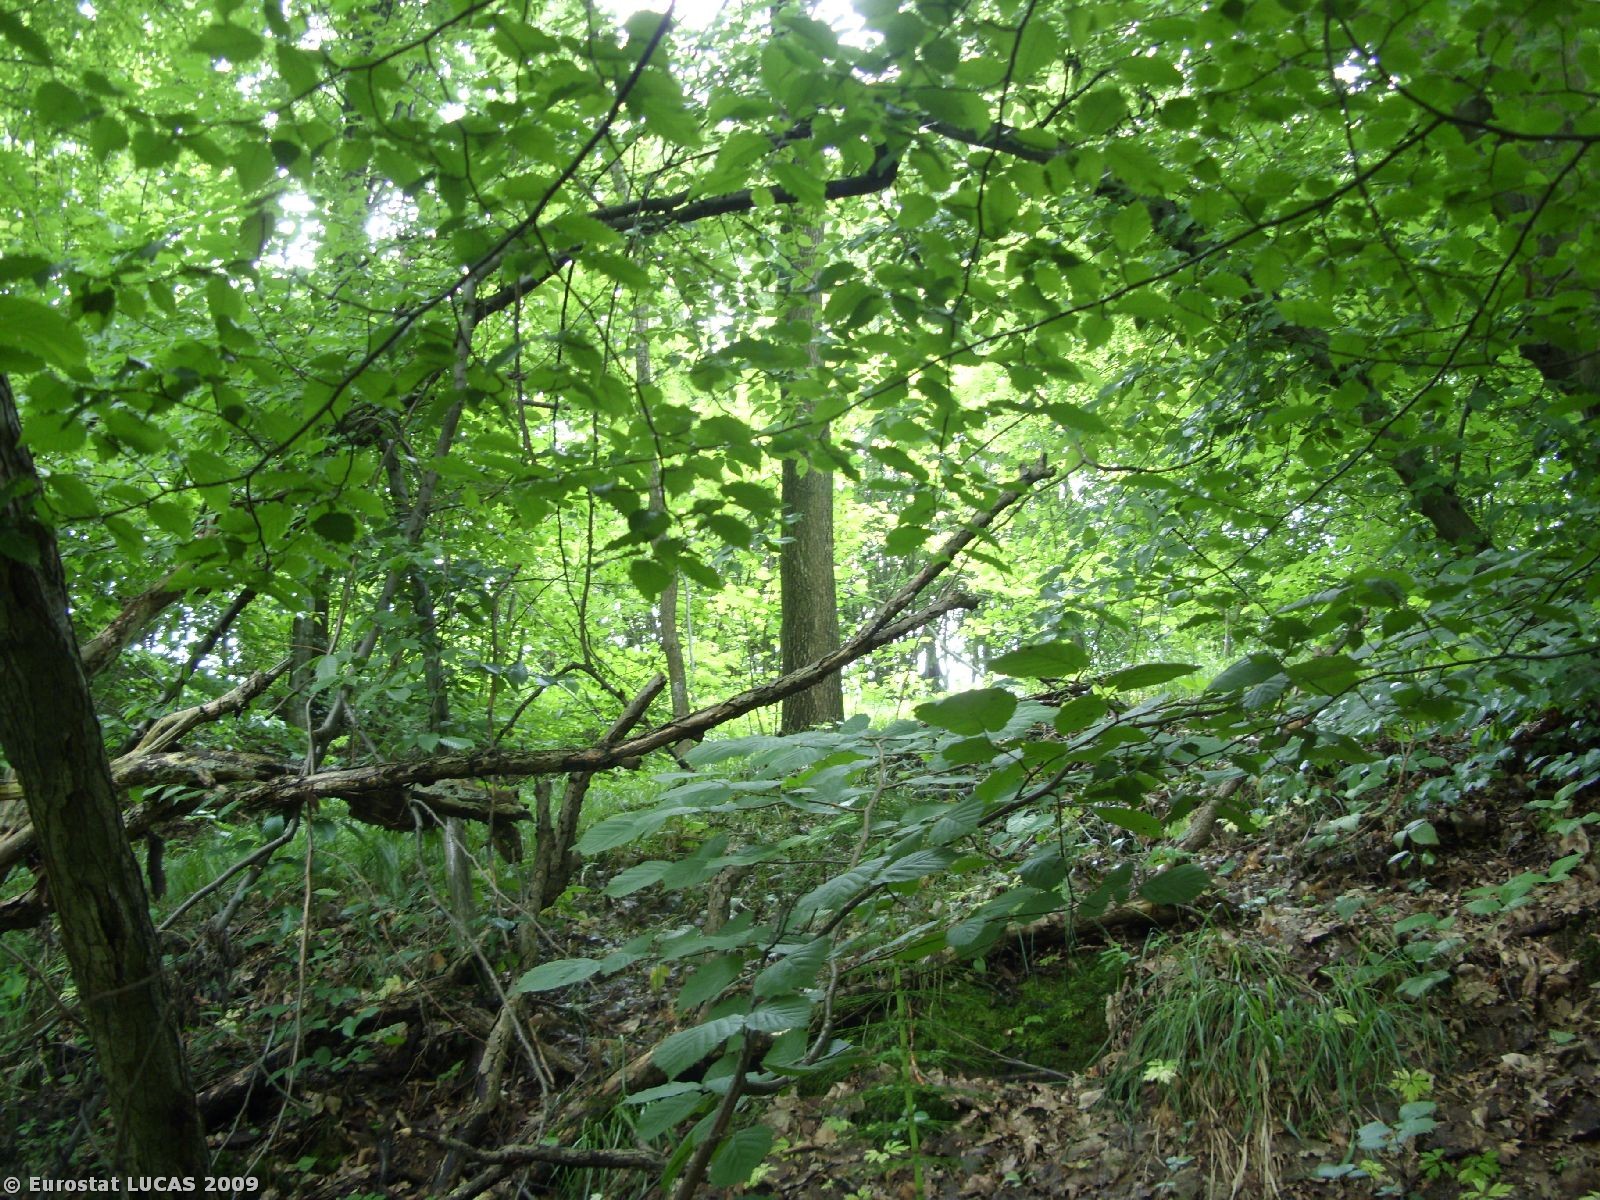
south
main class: Woodland
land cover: Broadleaved woodland
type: mesophytic deciduous forest
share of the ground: > 75 %
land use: Unused
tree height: > 5 m
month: June
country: PL
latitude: 49.8371
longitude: 20.1698
